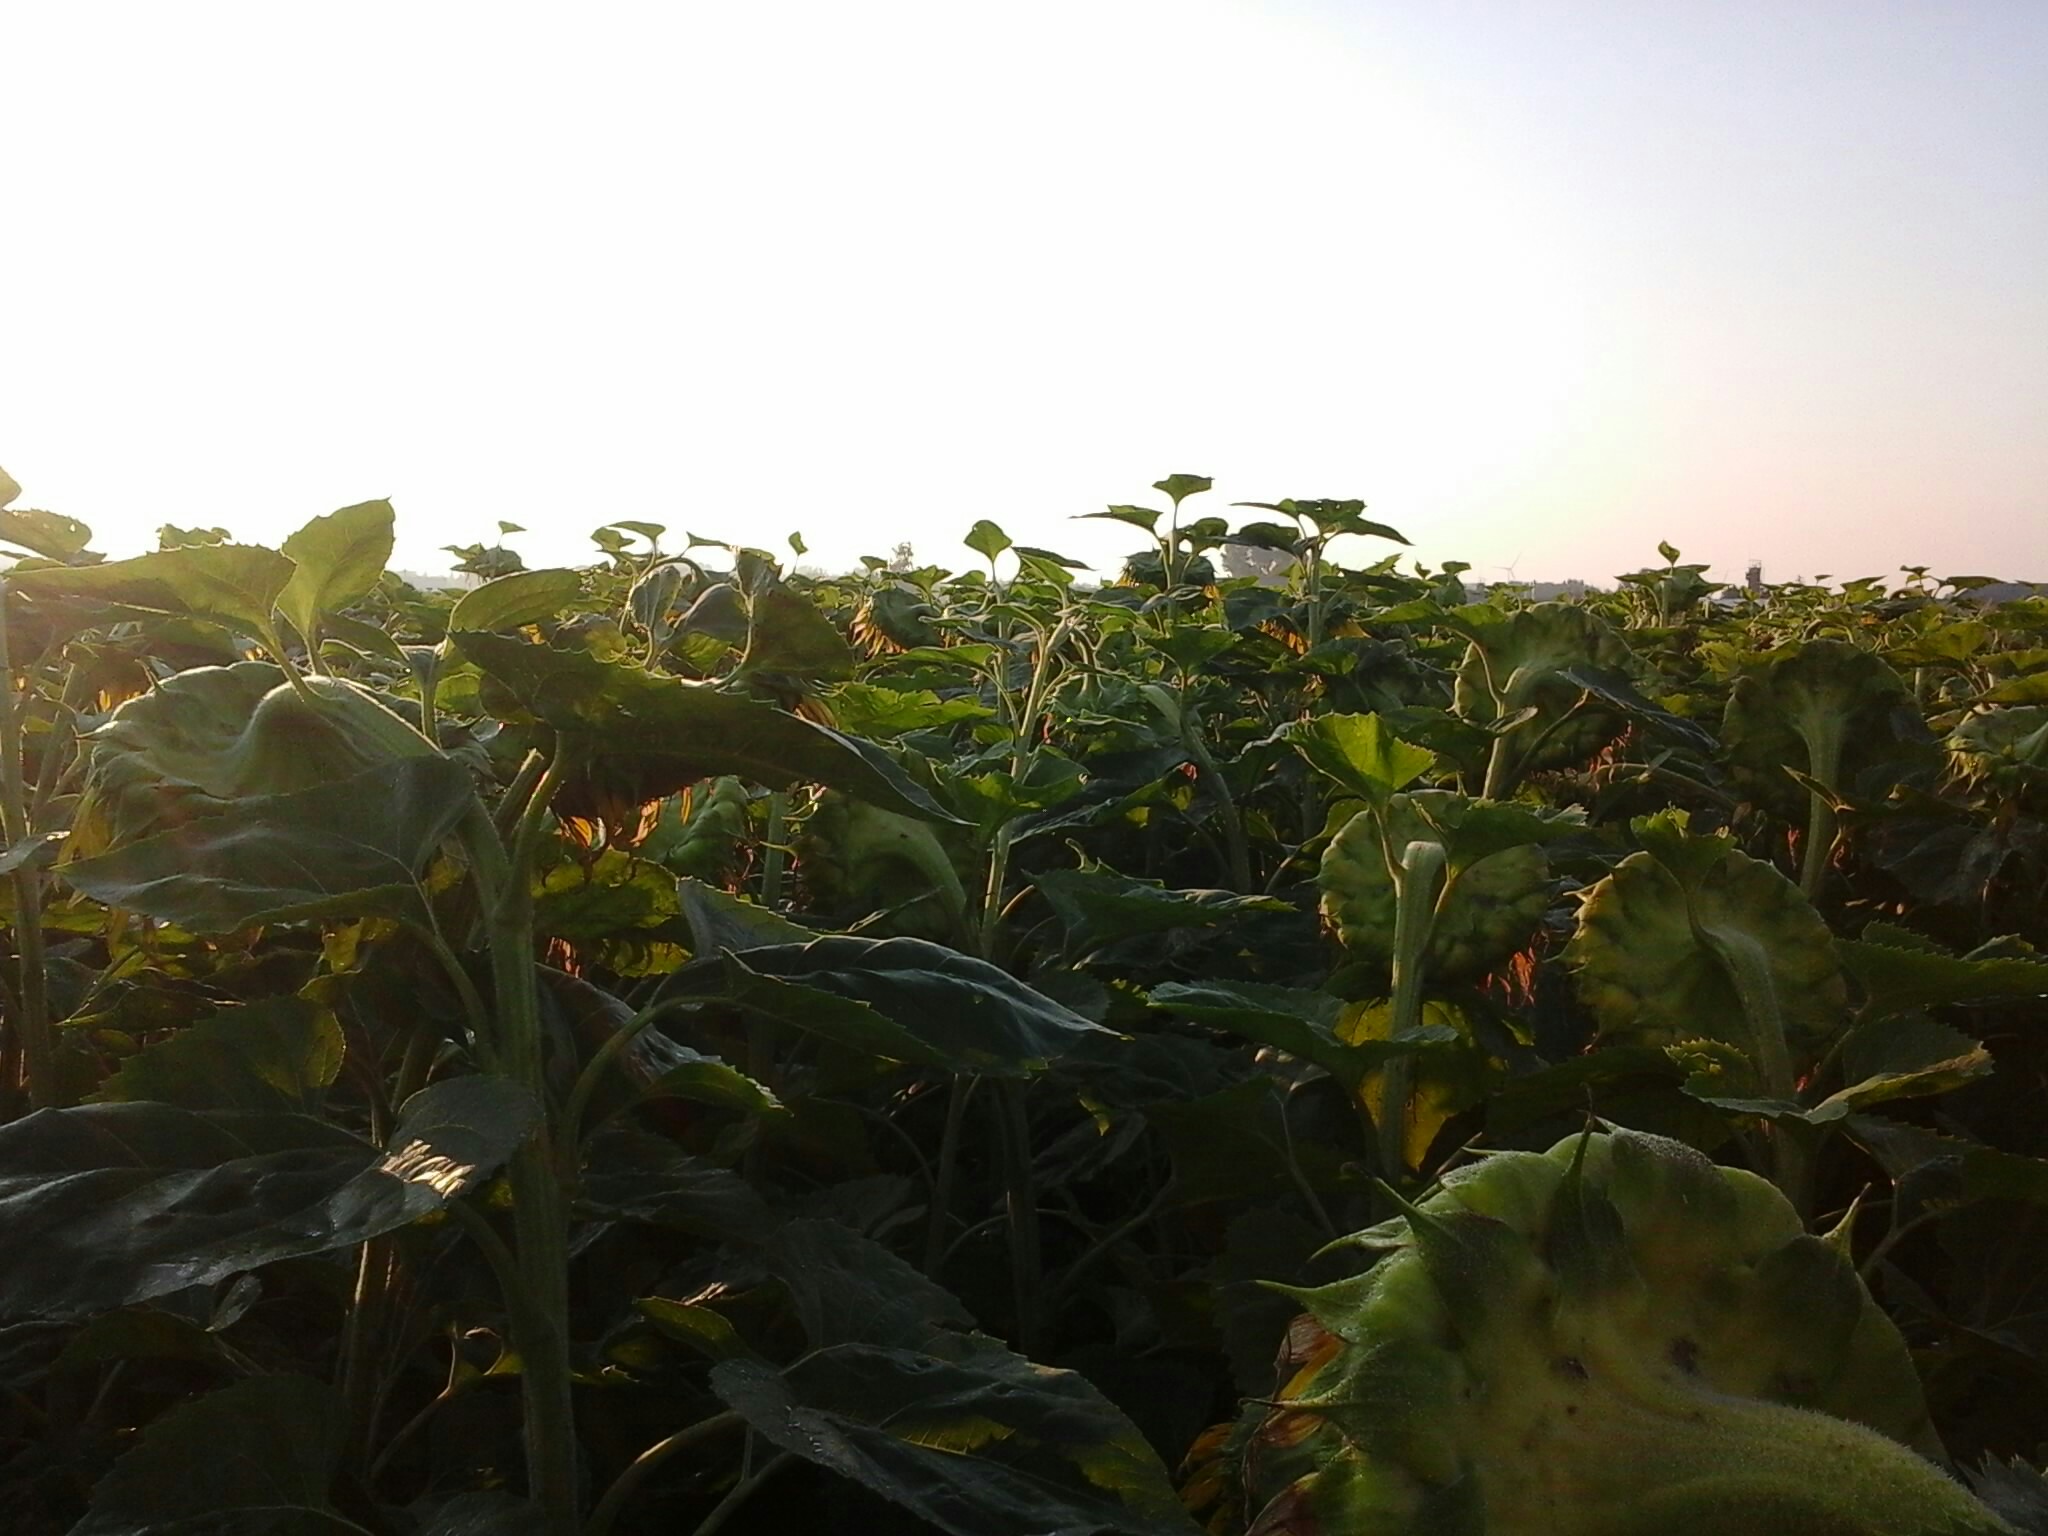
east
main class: Cropland
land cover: Sunflower
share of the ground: > 75 %
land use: Agriculture (excluding fallow land and kitchen gardens)
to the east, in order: Sunflower; Common wheat
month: August
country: HU
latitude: 47.6384
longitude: 18.0642
